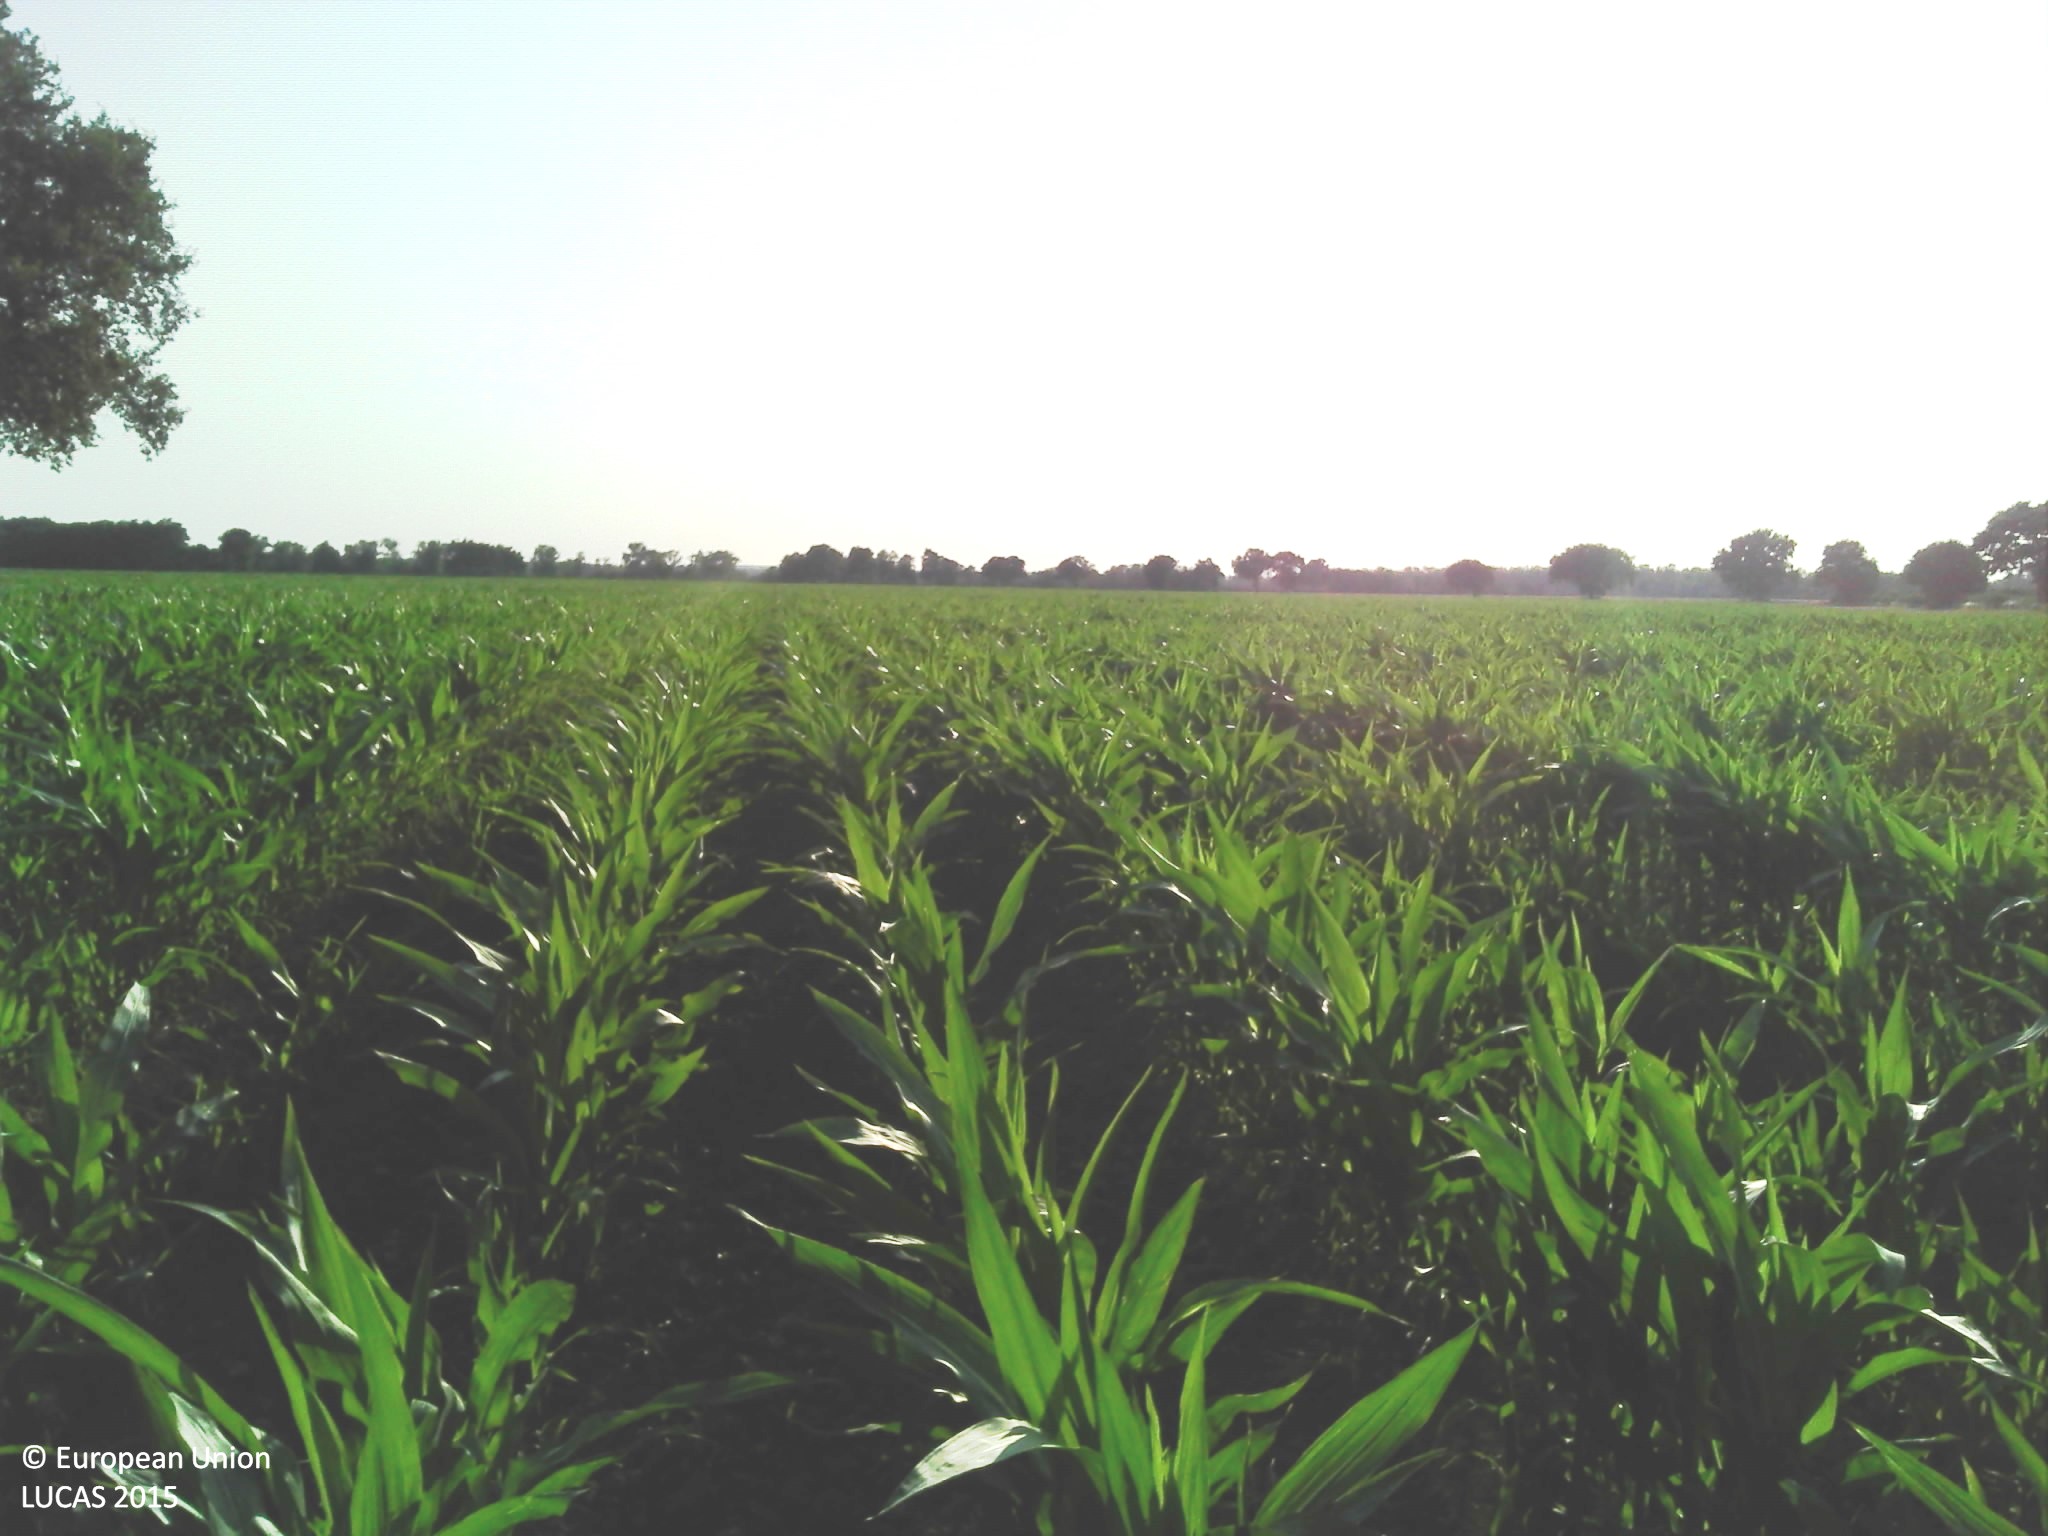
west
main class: Cropland
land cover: Maize
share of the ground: > 75 %
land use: Agriculture (excluding fallow land and kitchen gardens)
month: July
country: FR
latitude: 46.7897
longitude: 3.5662
